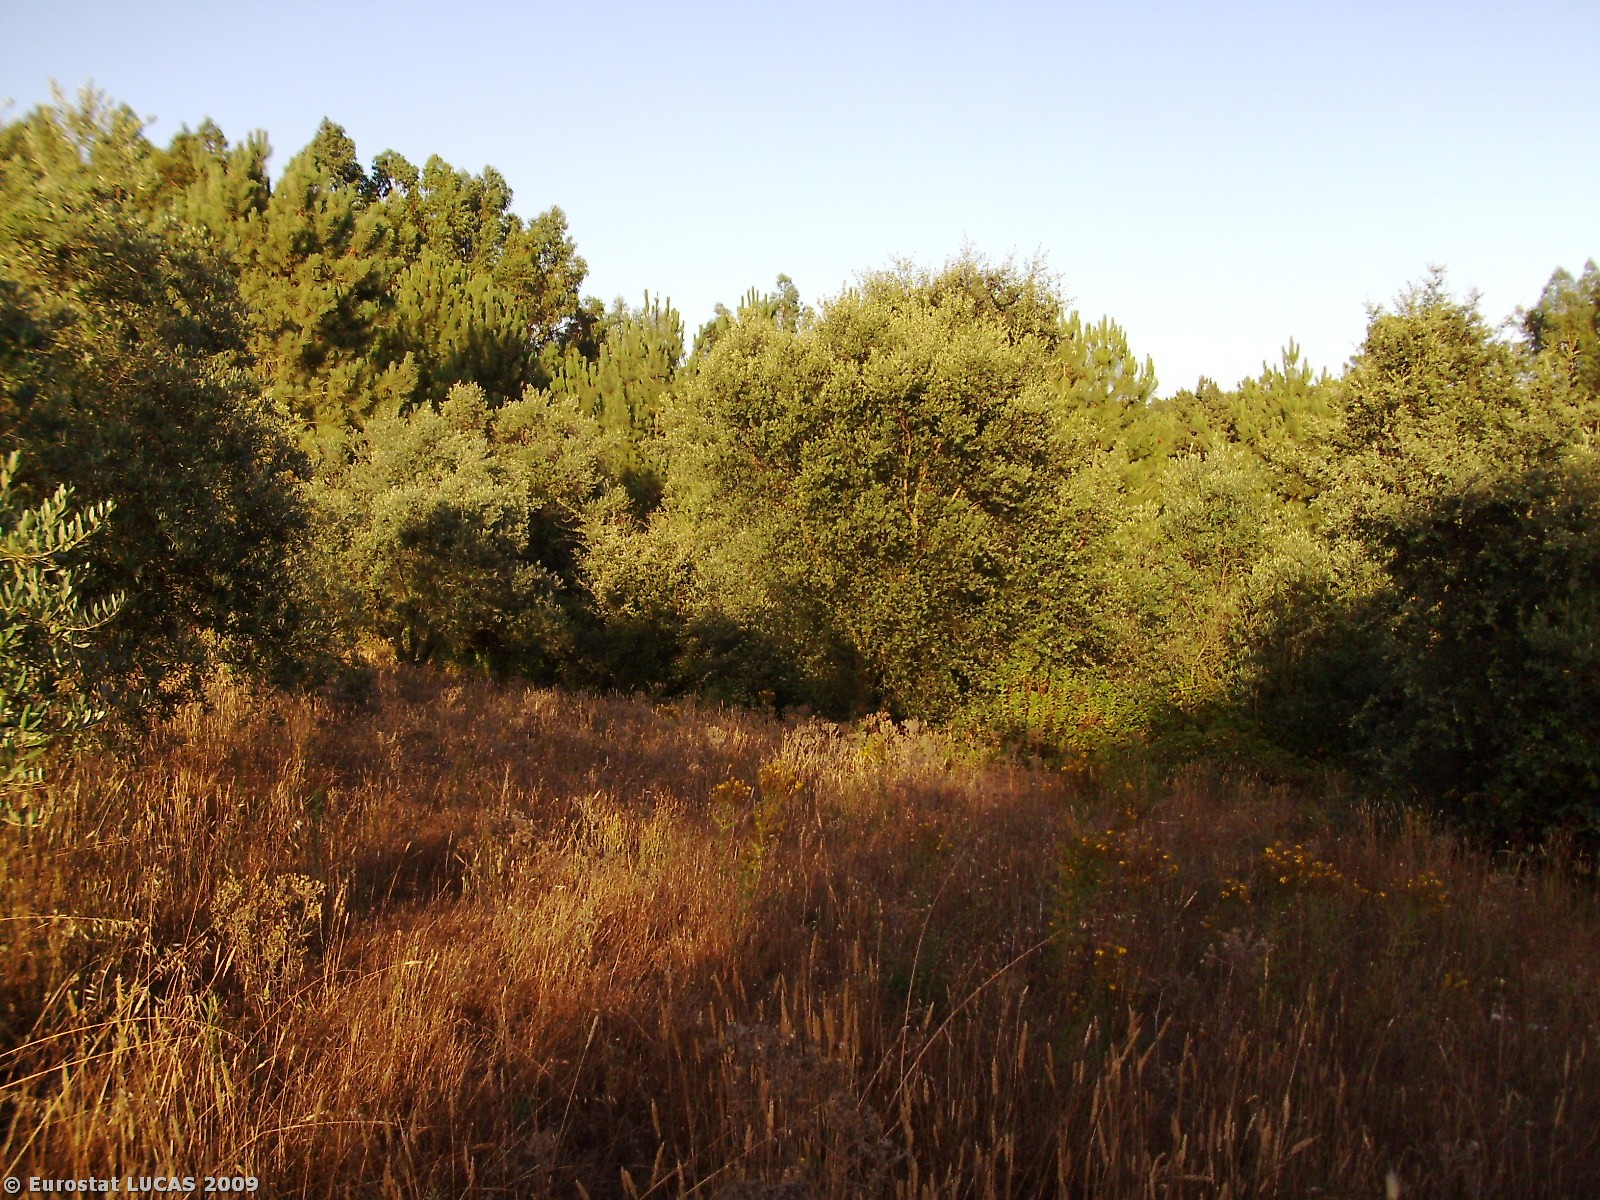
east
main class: Cropland
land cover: Olive groves
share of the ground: 25 - 50 %
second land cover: Spontaneously vegetated surfaces
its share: 50 - 75 %
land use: Agriculture (excluding fallow land and kitchen gardens)
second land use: Fallow land
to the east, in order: Olive groves; Spontaneously vegetated surfaces; Olive groves; Shrubland with sparse tree cover; Broadleaved woodland; Shrubland with sparse tree cover; Coniferous woodland; Shrubland with sparse tree cover; Rivers and streams; Shrubland with sparse tree cover; Broadleaved woodland; Tracks; Broadleaved woodland
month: July
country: PT
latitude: 39.3223
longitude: -8.8826
